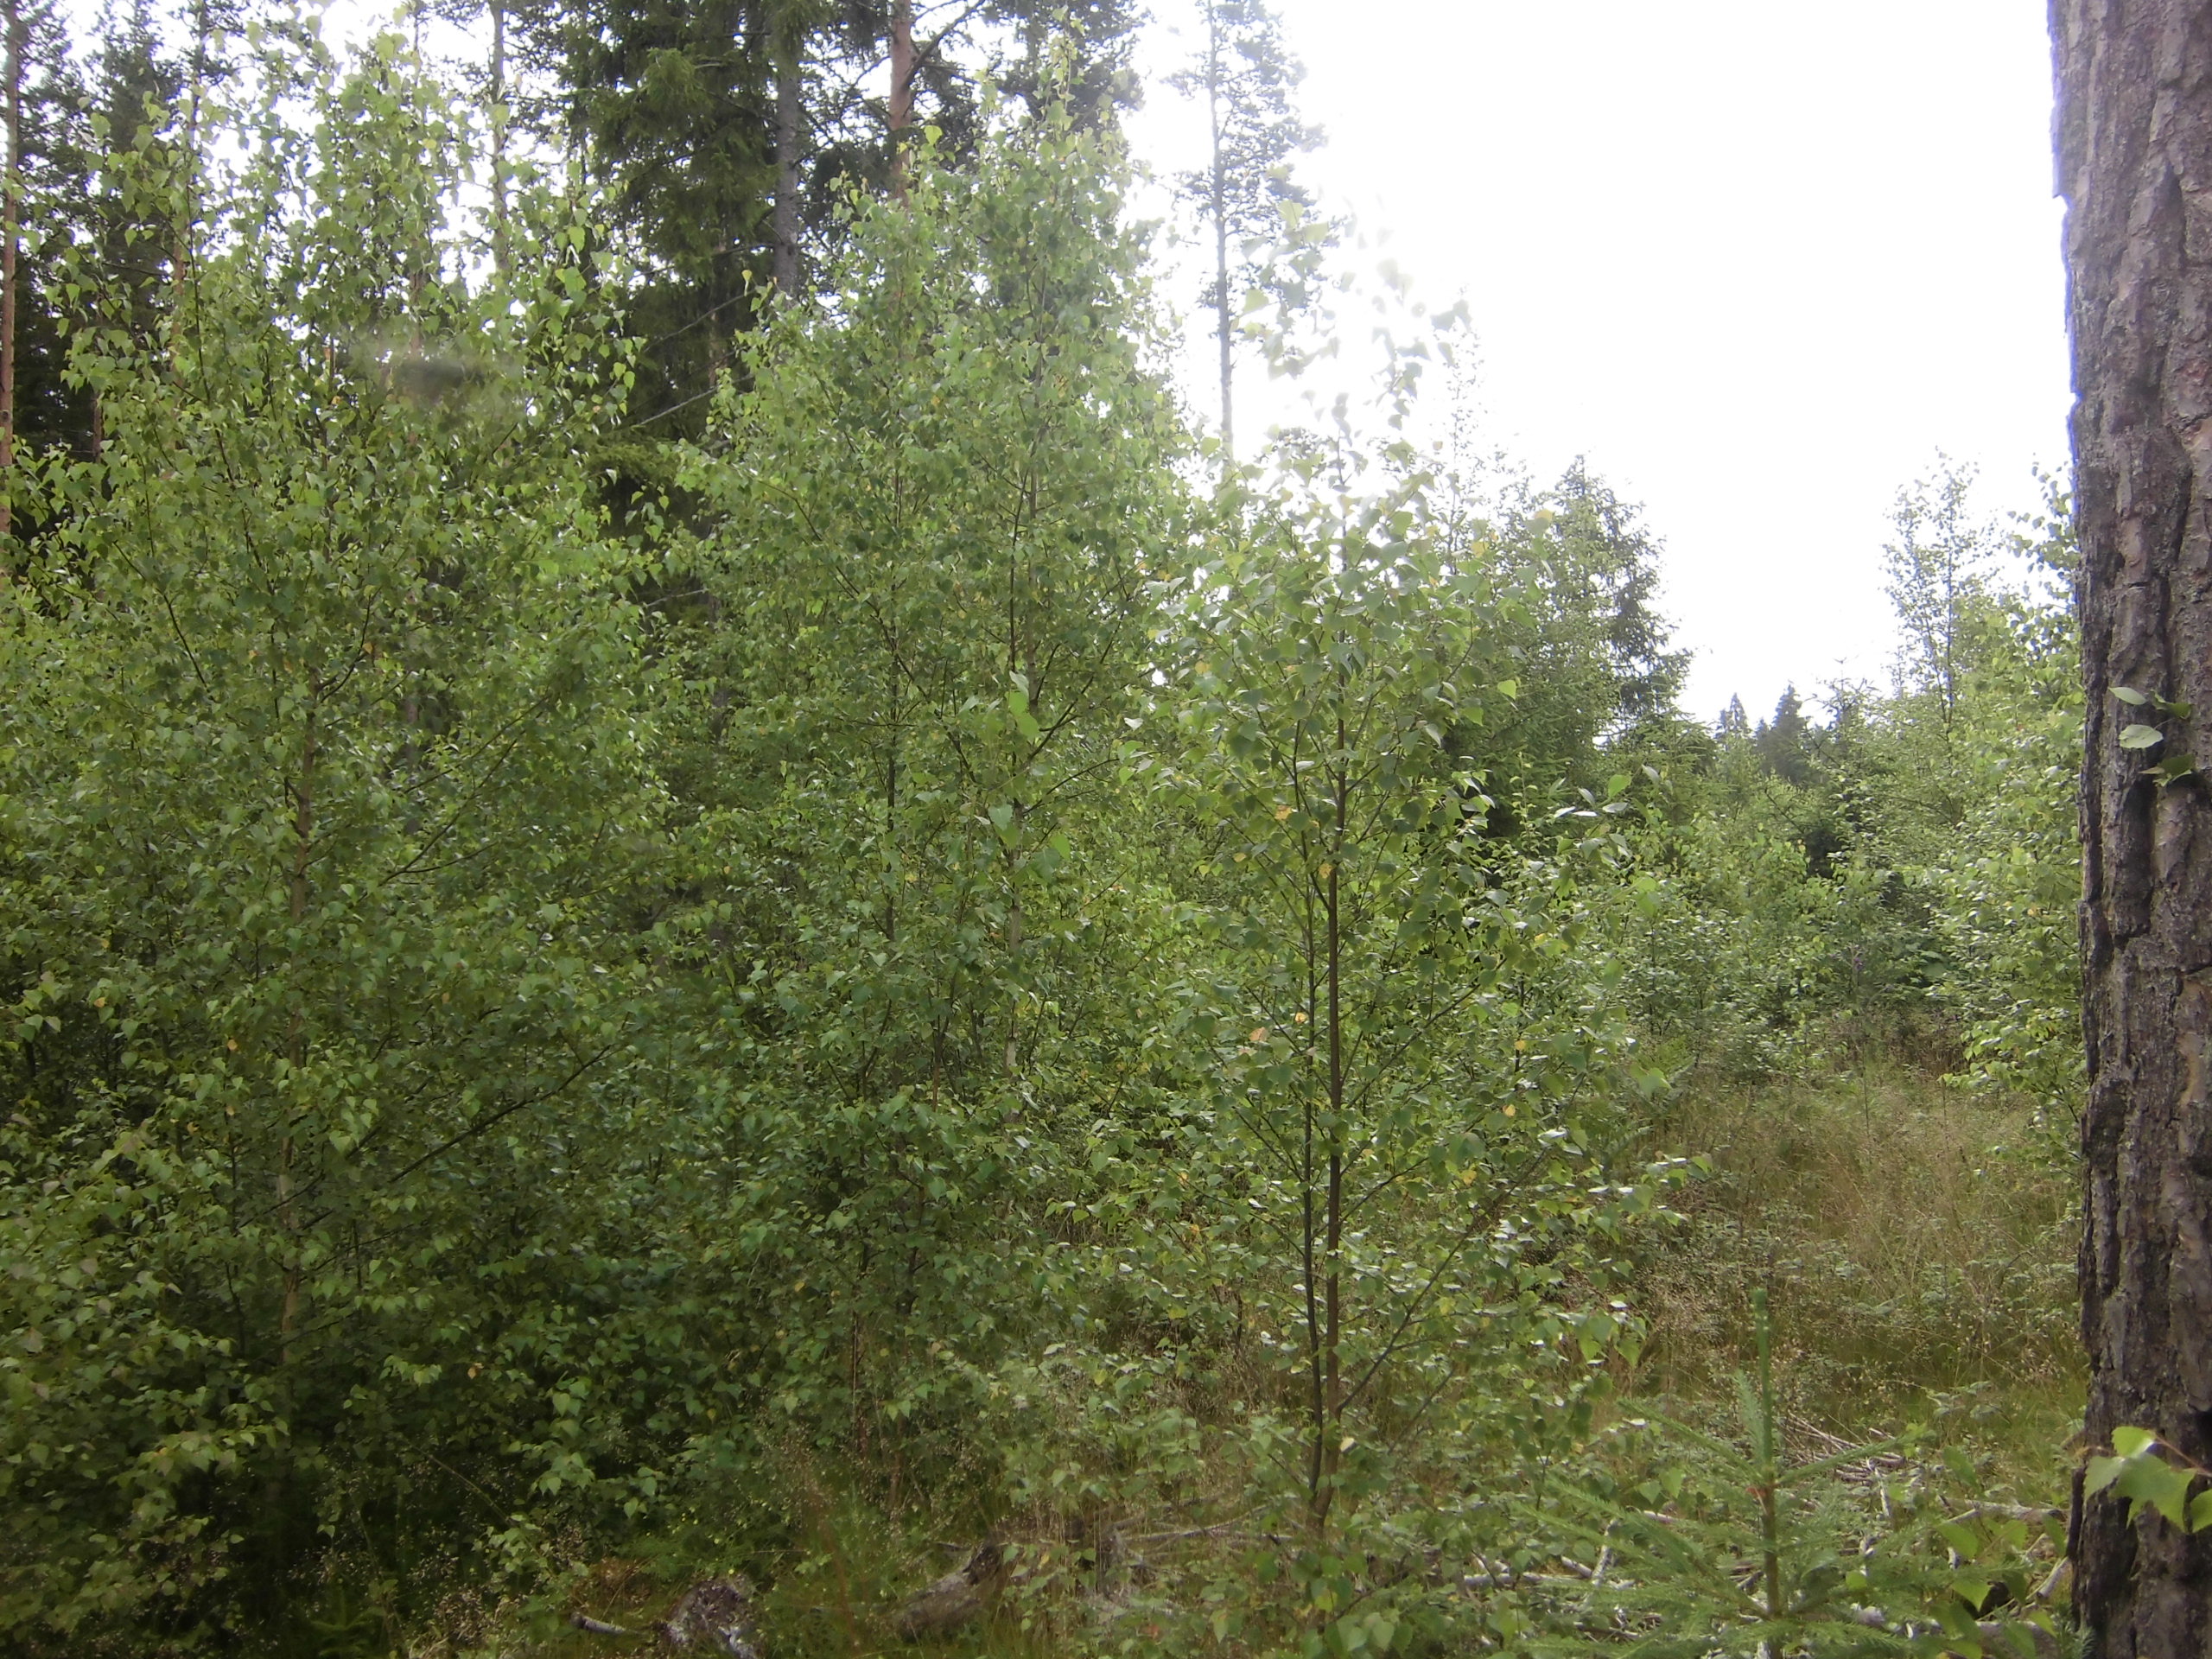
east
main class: Woodland
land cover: Pine dominated mixed woodland
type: boreal forest
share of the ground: 50 - 75 %
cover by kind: broadleaved forest trees 35 %, coniferous forest trees 25 %, herbaceous plants 20 %, shrubs 10 %, lichens and mosses 10 %
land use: Forestry
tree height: > 5 m
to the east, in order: Pine dominated mixed woodland; Spruce dominated mixed woodland; Spruce dominated coniferous woodland; Tracks; Spruce dominated coniferous woodland; Tracks; Spruce dominated coniferous woodland; Tracks; Spruce dominated coniferous woodland
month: July
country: SE
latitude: 57.4450
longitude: 14.9114
